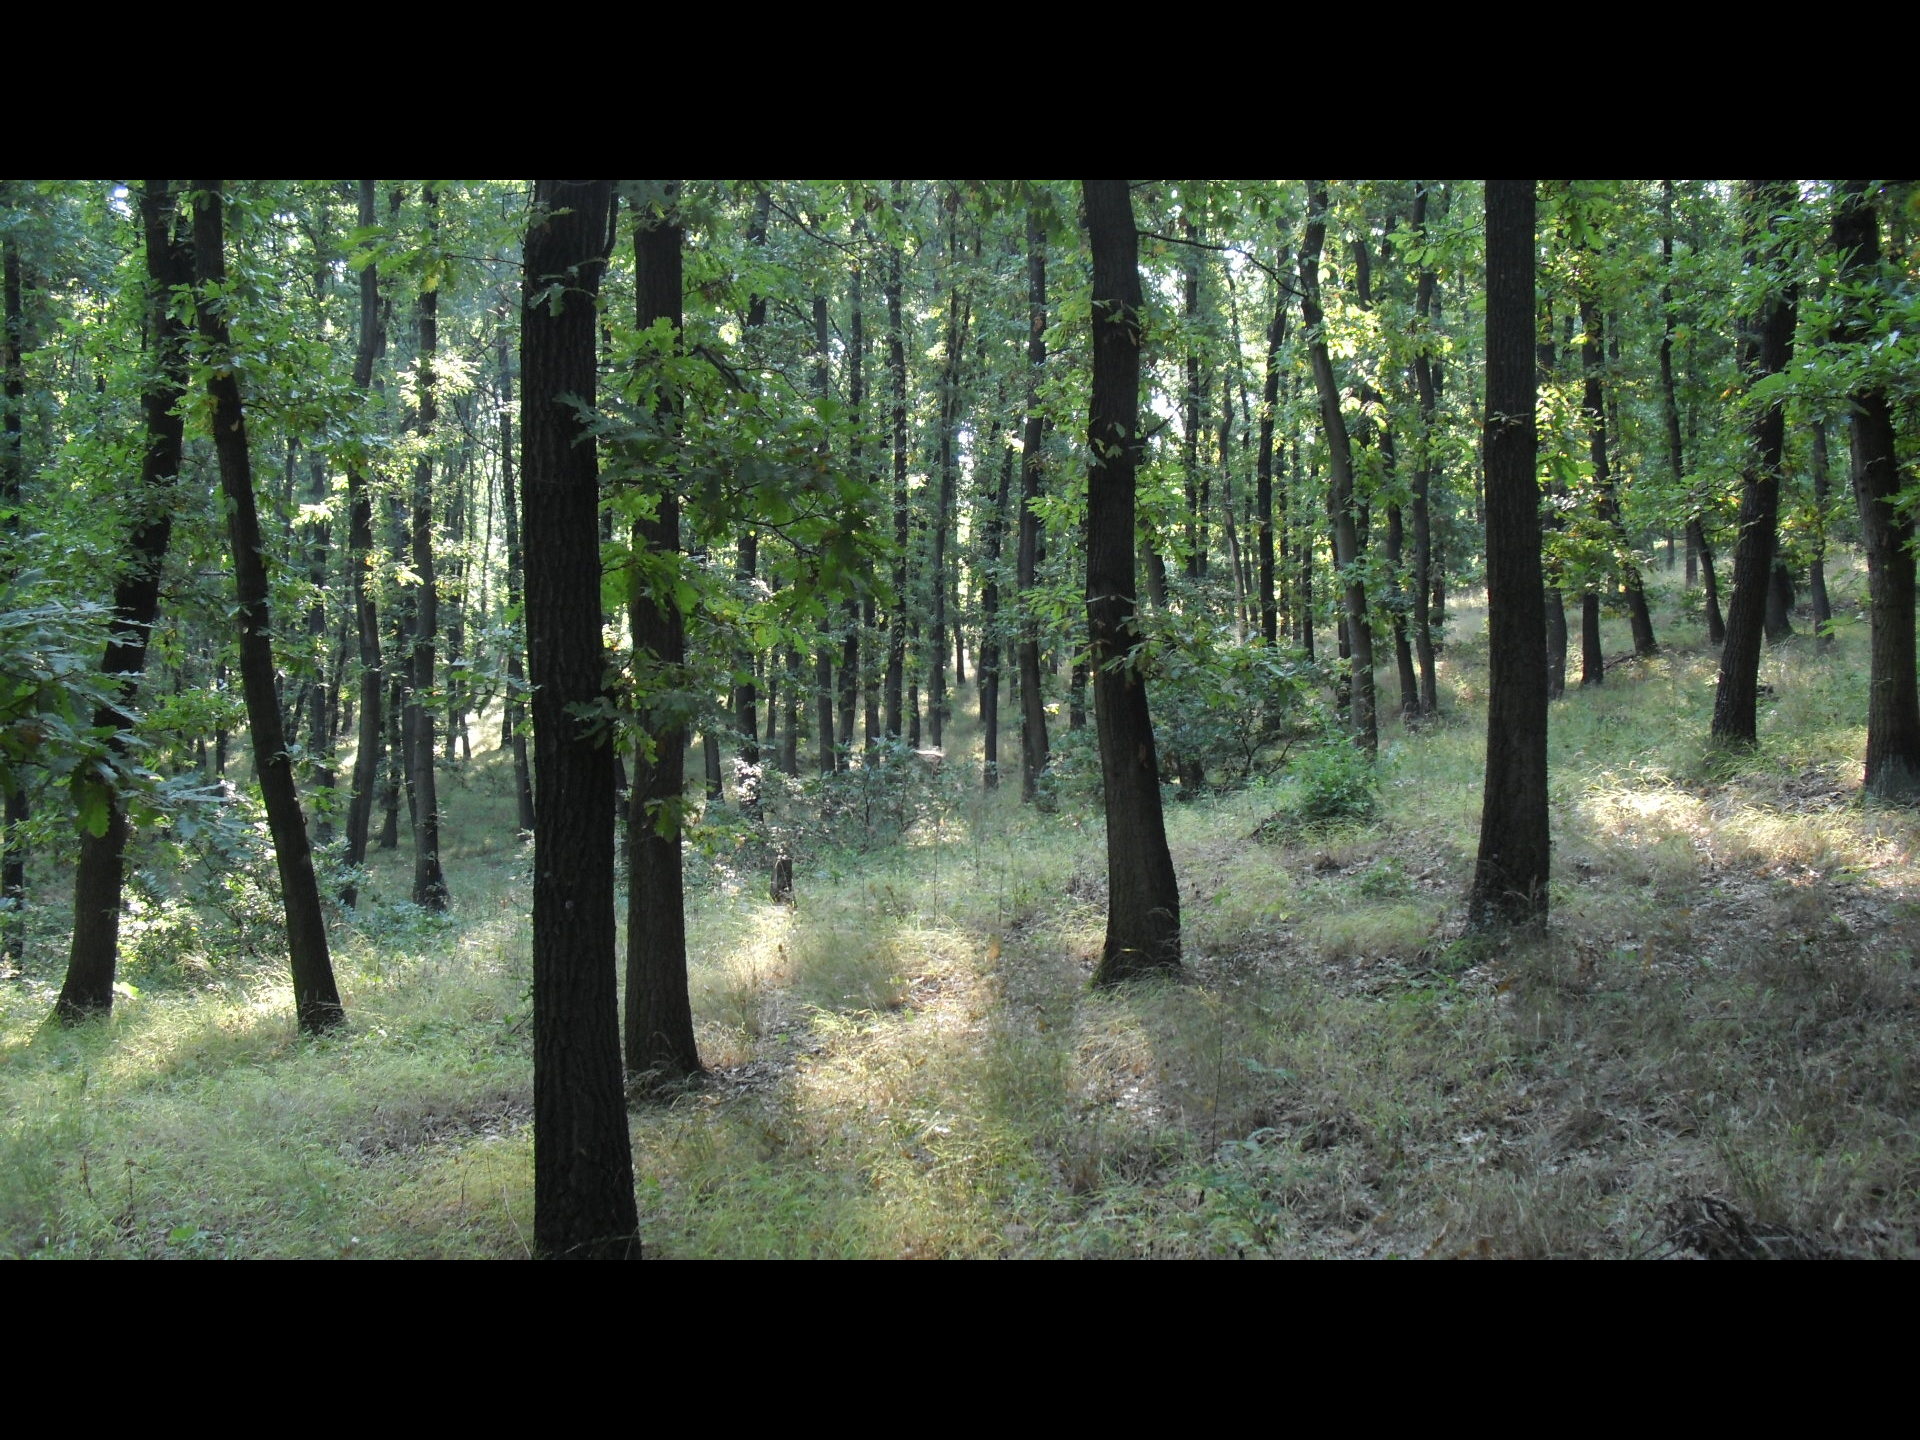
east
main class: Woodland
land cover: Broadleaved woodland
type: mesophytic deciduous forest
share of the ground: > 75 %
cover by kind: broadleaved forest trees 85 %, herbaceous plants 15 %
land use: Forestry
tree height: > 5 m
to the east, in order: Broadleaved woodland; Tracks; Broadleaved woodland; Tracks; Broadleaved woodland
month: September
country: BG
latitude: 44.0496
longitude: 22.6302
